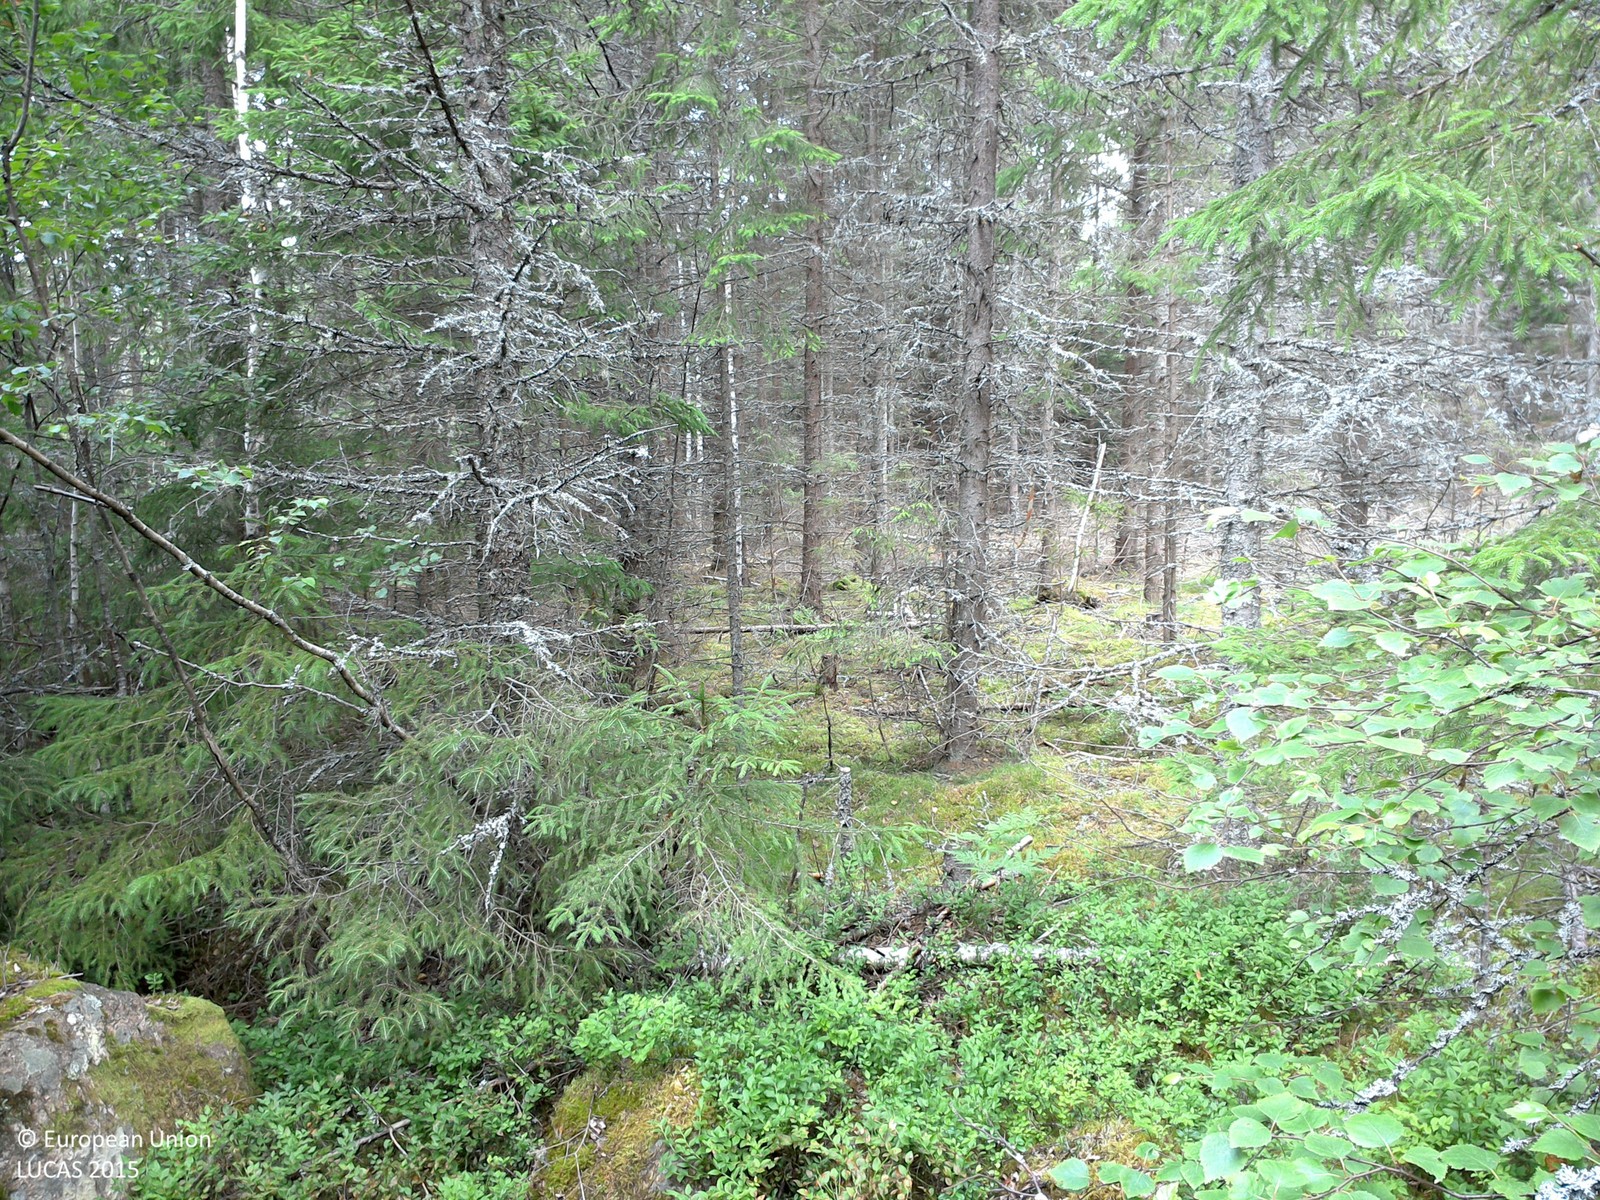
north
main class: Woodland
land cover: Spruce dominated mixed woodland
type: boreal forest
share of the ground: > 75 %
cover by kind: coniferous forest trees 55 %, broadleaved forest trees 20 %, lichens and mosses 20 %, herbaceous plants 5 %
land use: Forestry
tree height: > 5 m
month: July
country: SE
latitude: 58.2259
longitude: 14.7447
